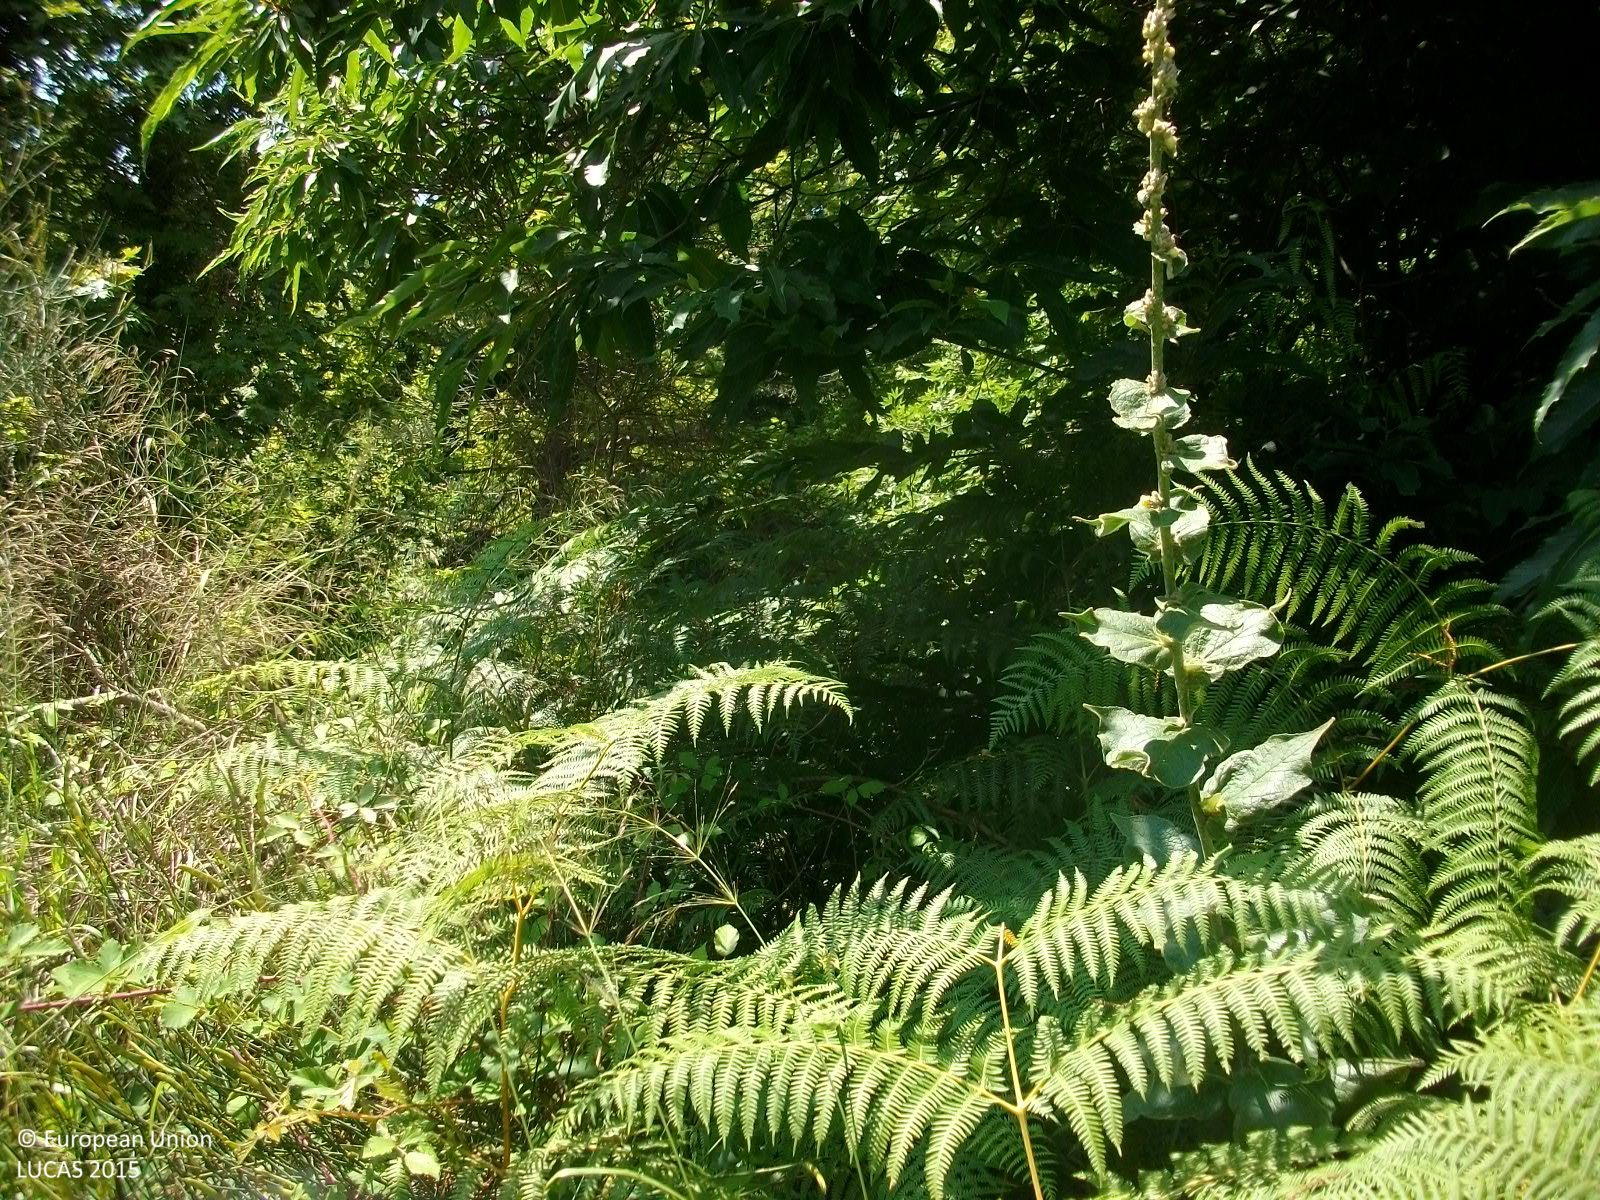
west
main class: Woodland
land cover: Broadleaved woodland
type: thermophilous deciduous forest
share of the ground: > 75 %
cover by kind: broadleaved forest trees 90 %, herbaceous plants 10 %
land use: Forestry
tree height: > 5 m
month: July
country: GR
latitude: 39.4141
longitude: 23.1538
